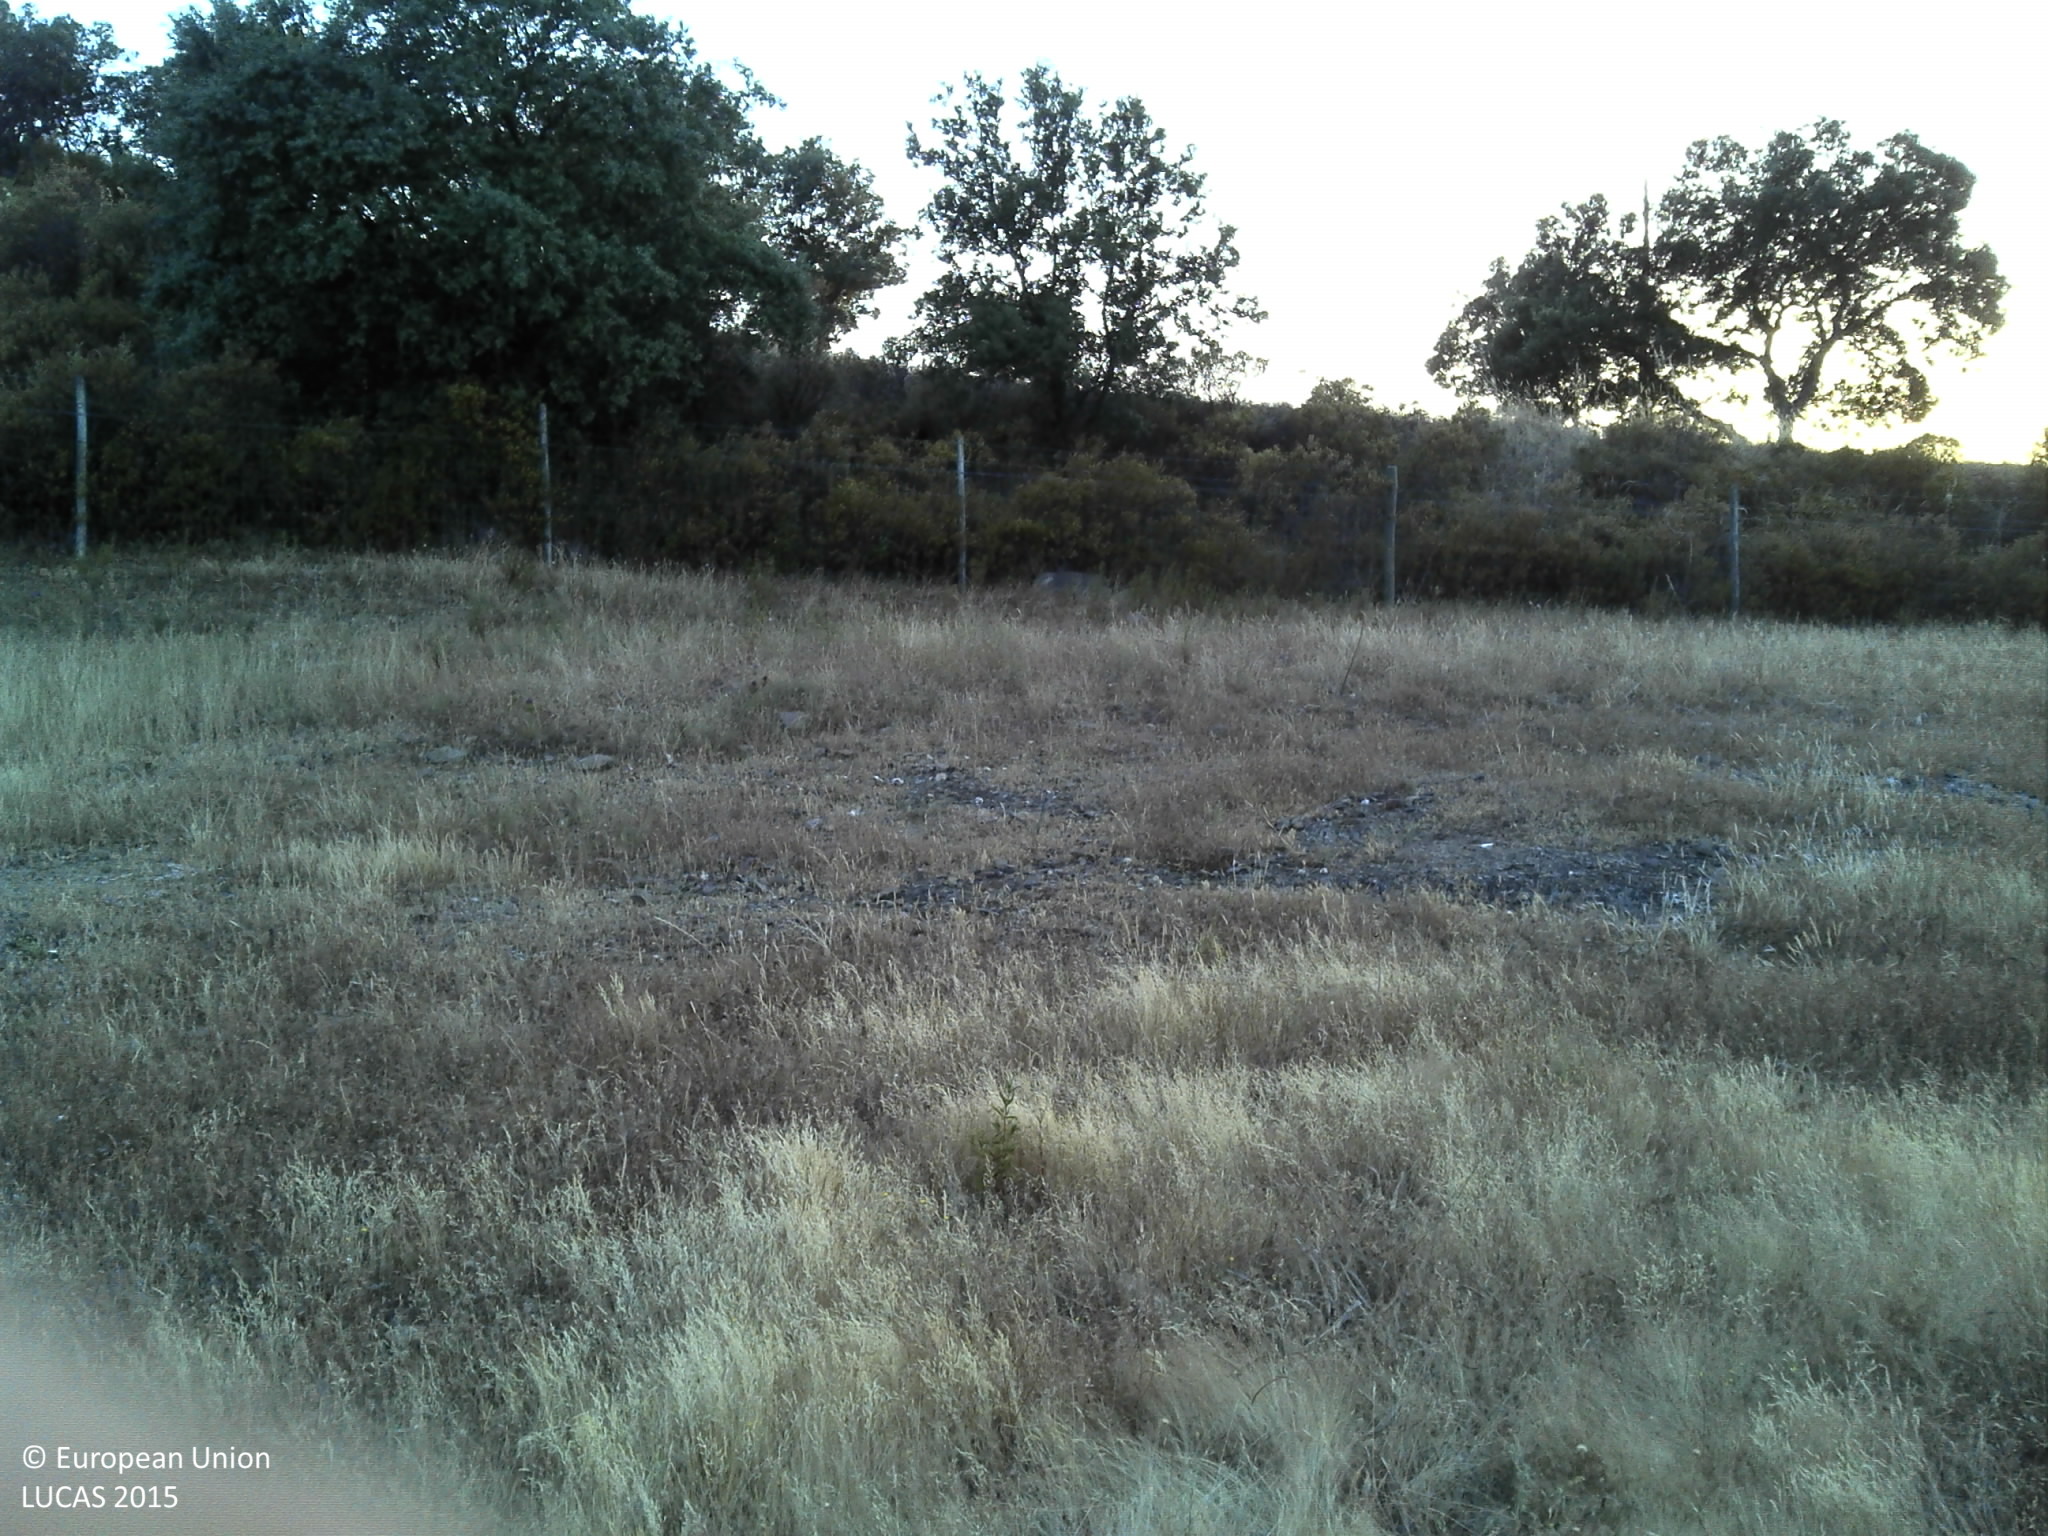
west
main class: Grassland
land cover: Grassland without tree/shrub cover
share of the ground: > 75 %
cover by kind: herbaceous plants 100 %
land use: Agriculture (excluding fallow land and kitchen gardens)
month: June
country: PT
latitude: 37.6025
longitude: -7.5350
